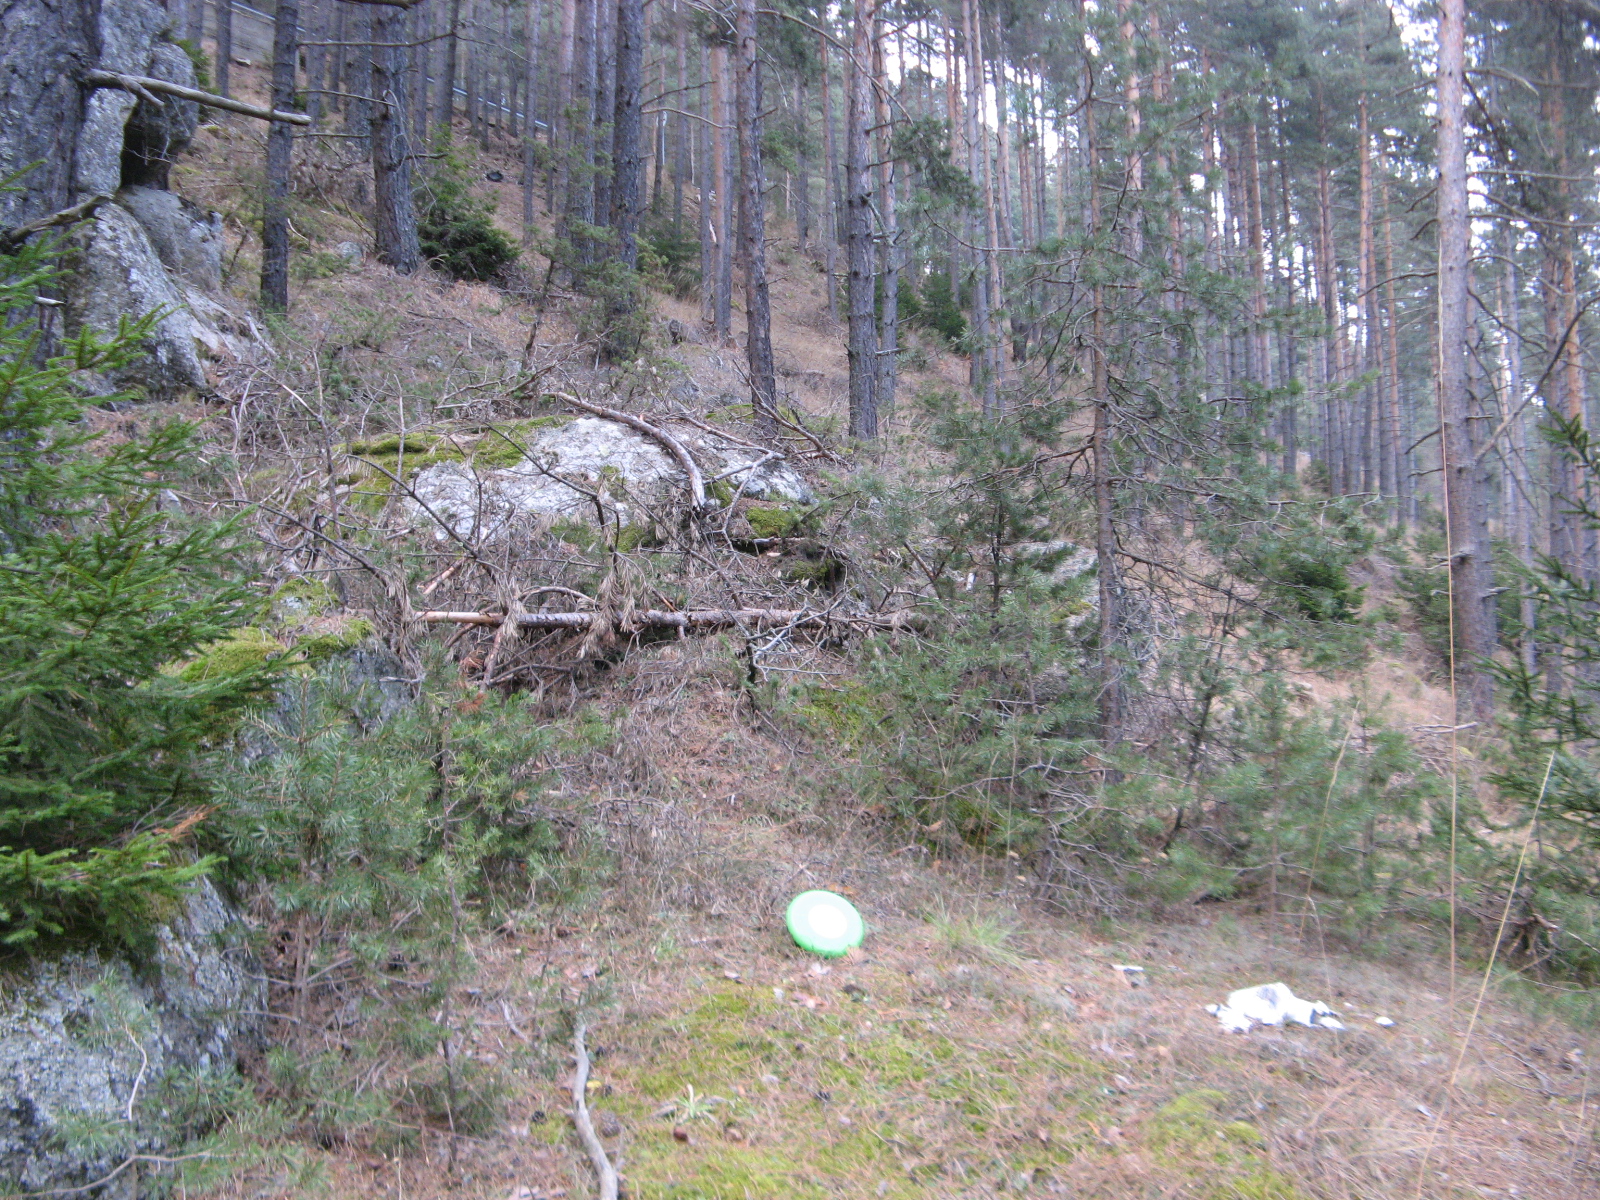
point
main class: Woodland
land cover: Pine dominated coniferous woodland
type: hemiboreal forest and nemoral coniferous forest and mixed broadleaved-coniferous forest
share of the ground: > 75 %
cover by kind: coniferous forest trees 85 %, herbaceous plants 5 %, lichens and mosses 5 %, unconsolidated bare surface 5 %
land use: Forestry
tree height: > 5 m
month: December
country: BG
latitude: 41.6345
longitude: 24.1647
